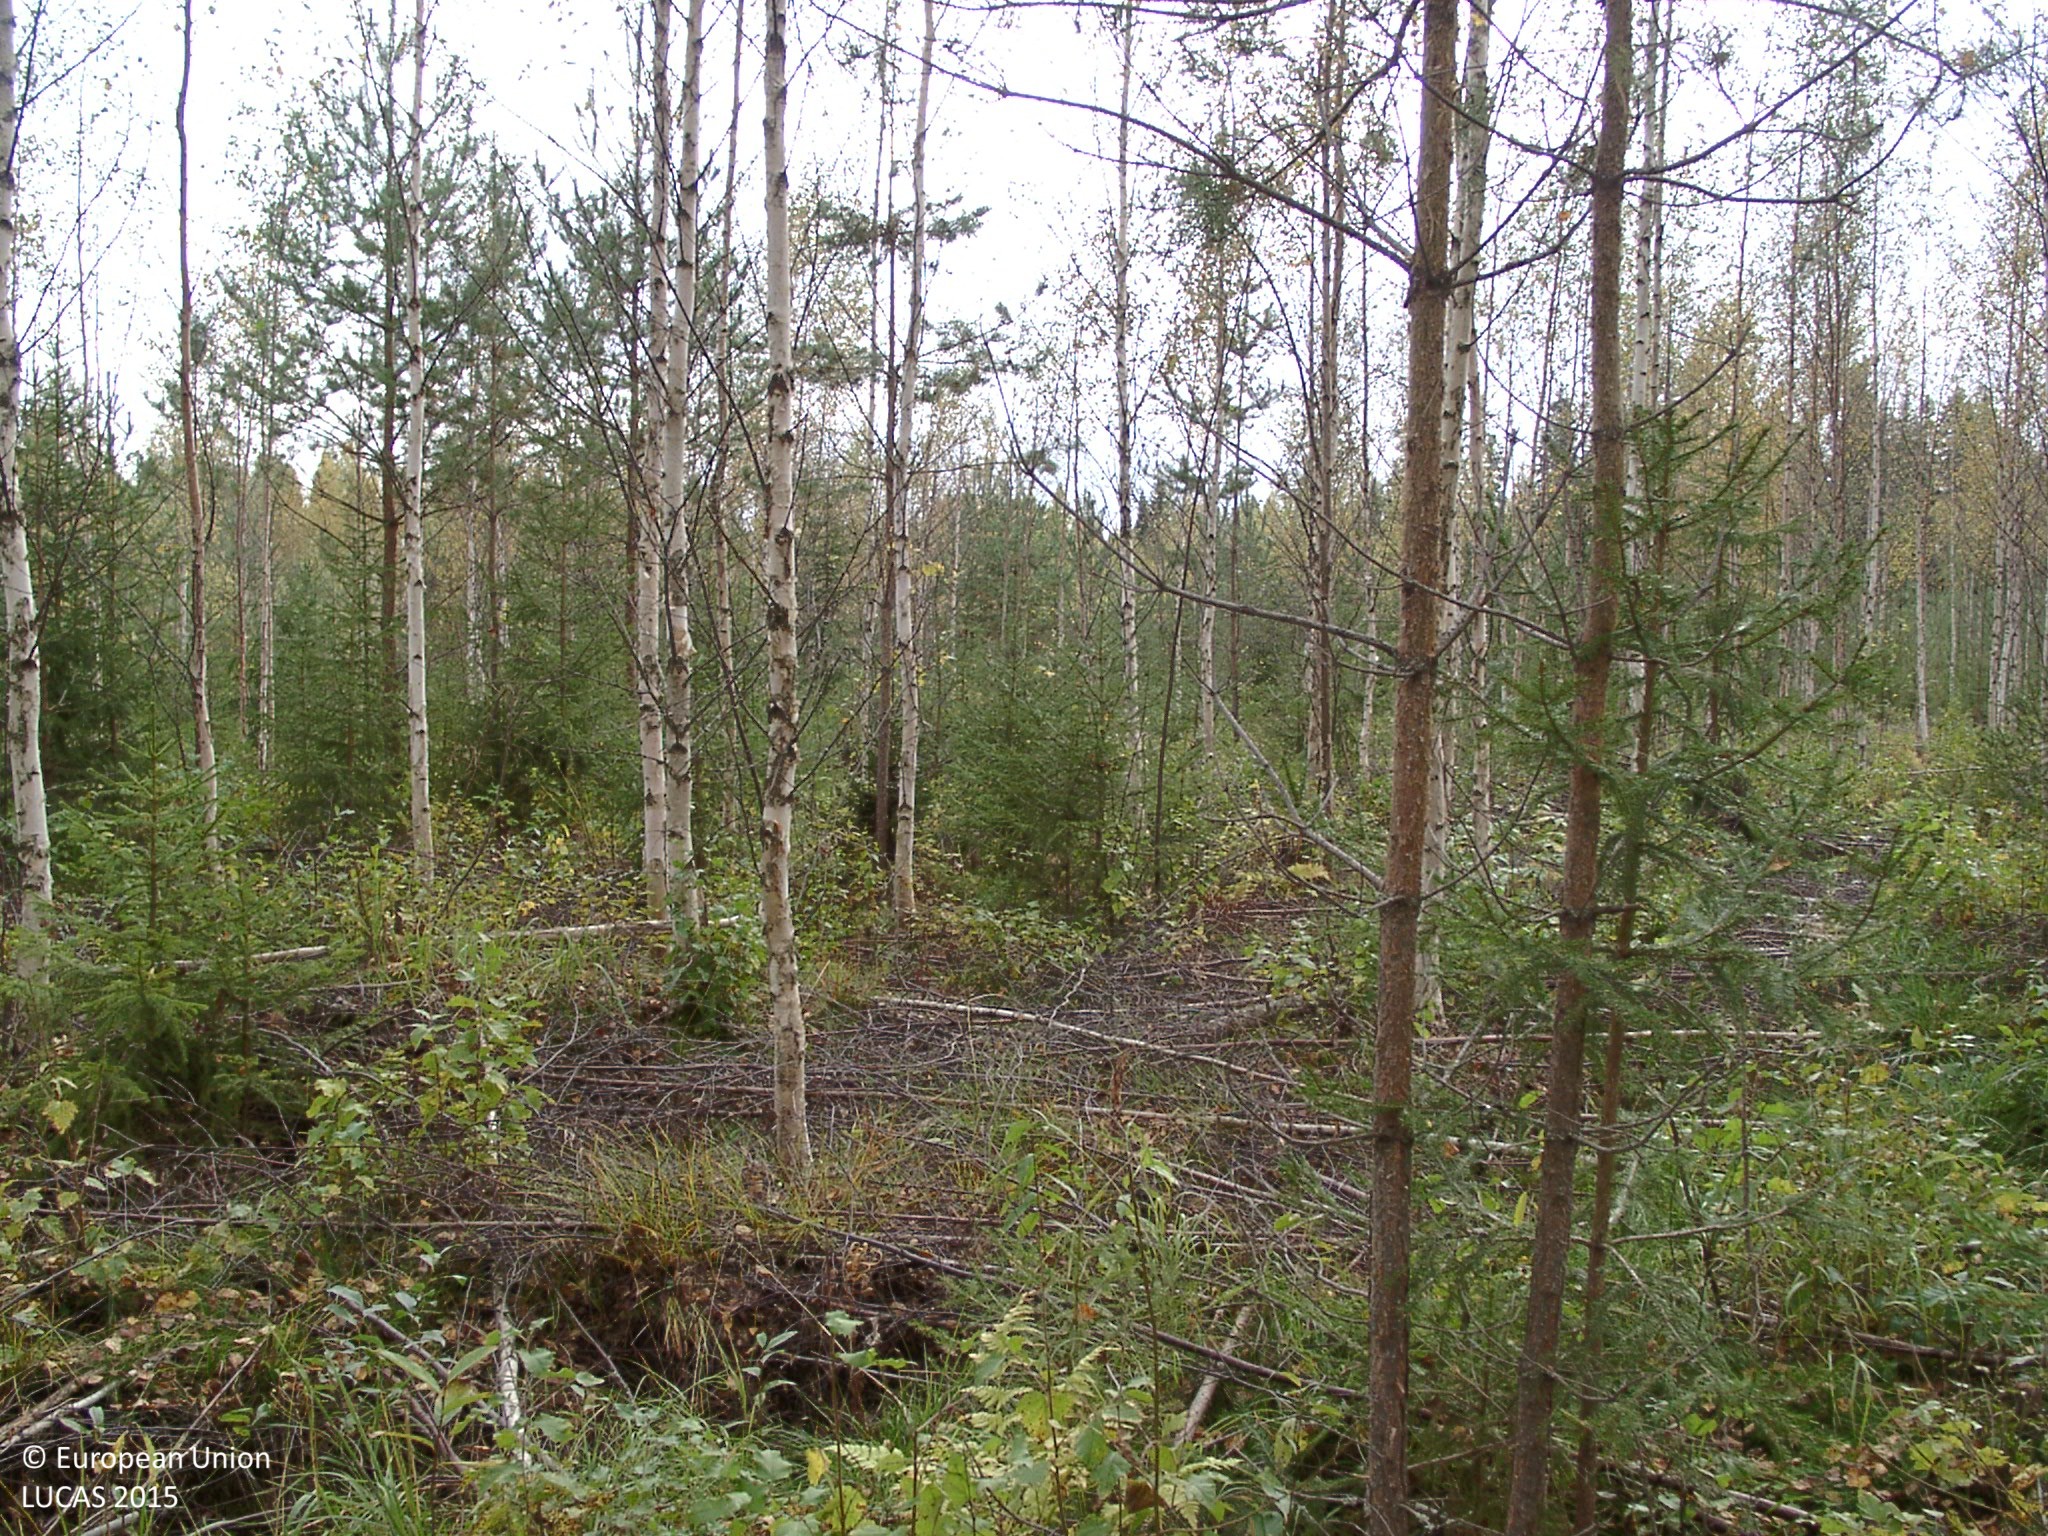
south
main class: Woodland
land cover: Spruce dominated mixed woodland
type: boreal forest
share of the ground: 50 - 75 %
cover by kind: broadleaved forest trees 60 %, coniferous forest trees 20 %, unconsolidated bare surface 10 %, shrubs 5 %, herbaceous plants 5 %
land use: Forestry
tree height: > 5 m
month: September
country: FI
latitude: 62.6623
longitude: 25.3907
